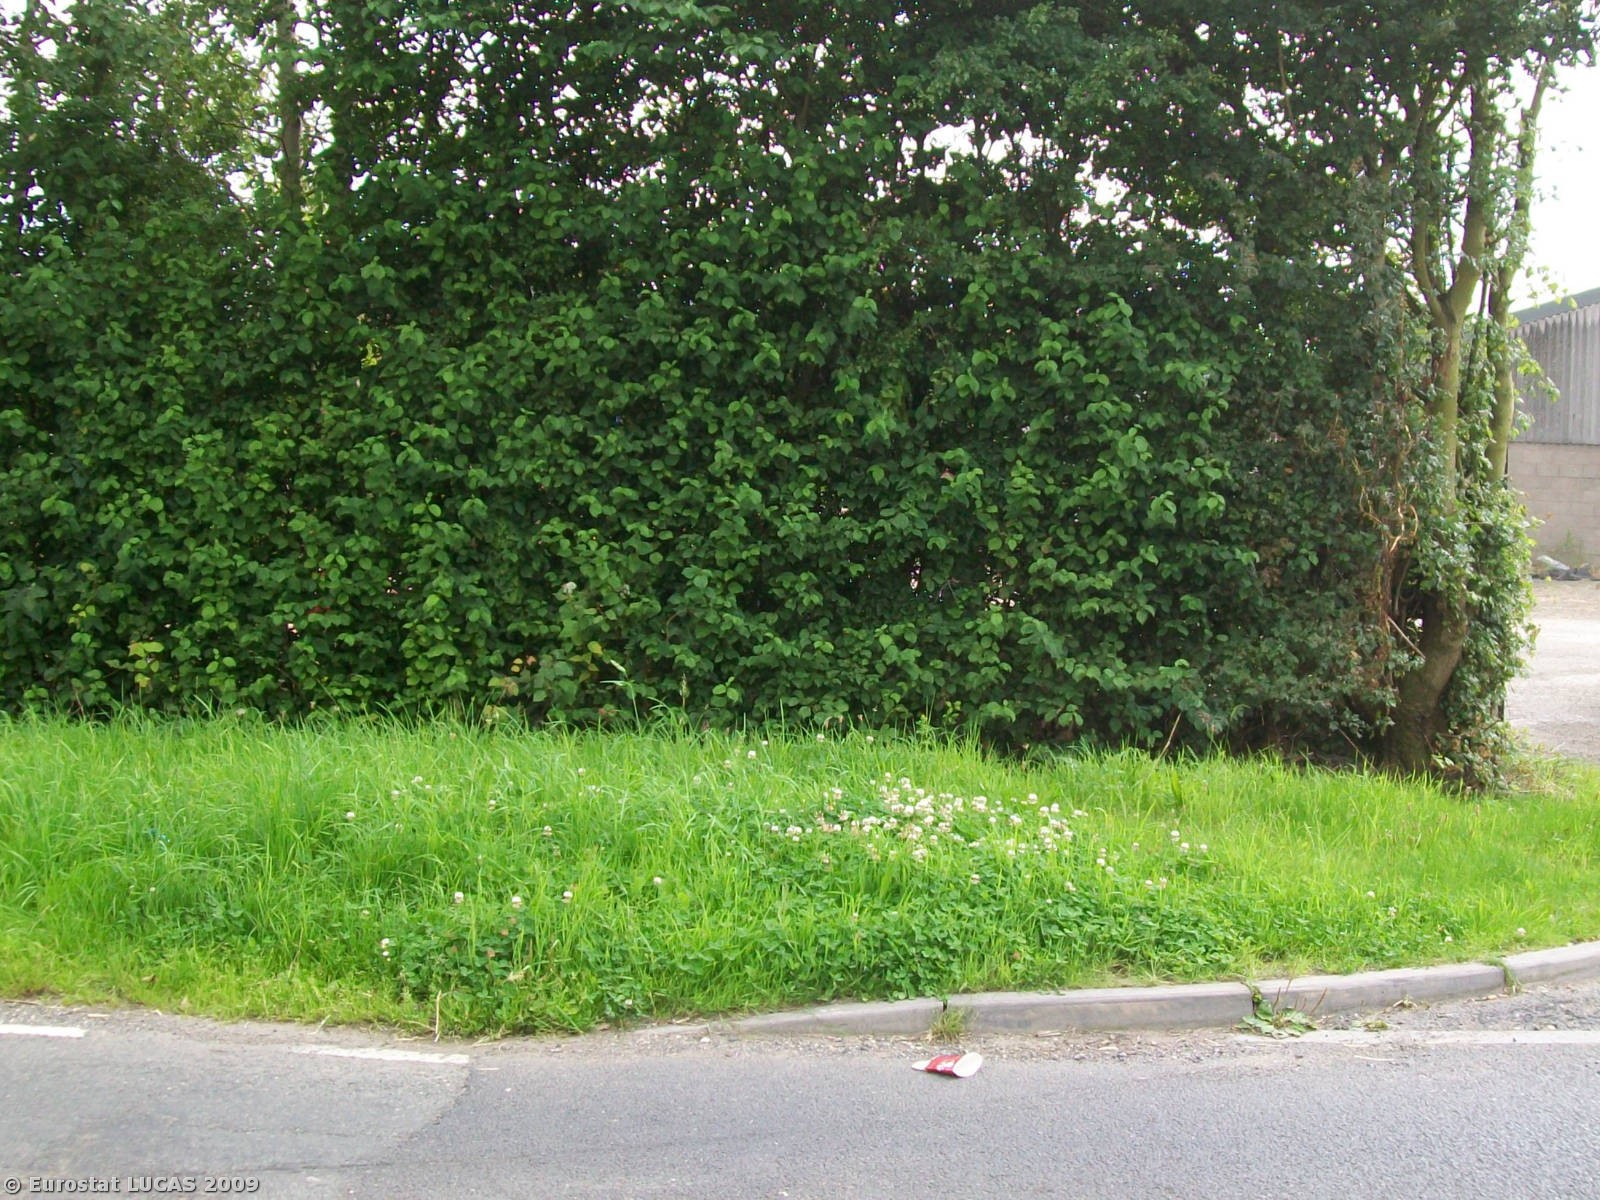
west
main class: Grassland
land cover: Grassland without tree/shrub cover
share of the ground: > 75 %
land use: Unused
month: August
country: GB
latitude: 53.3668
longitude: -1.2428
